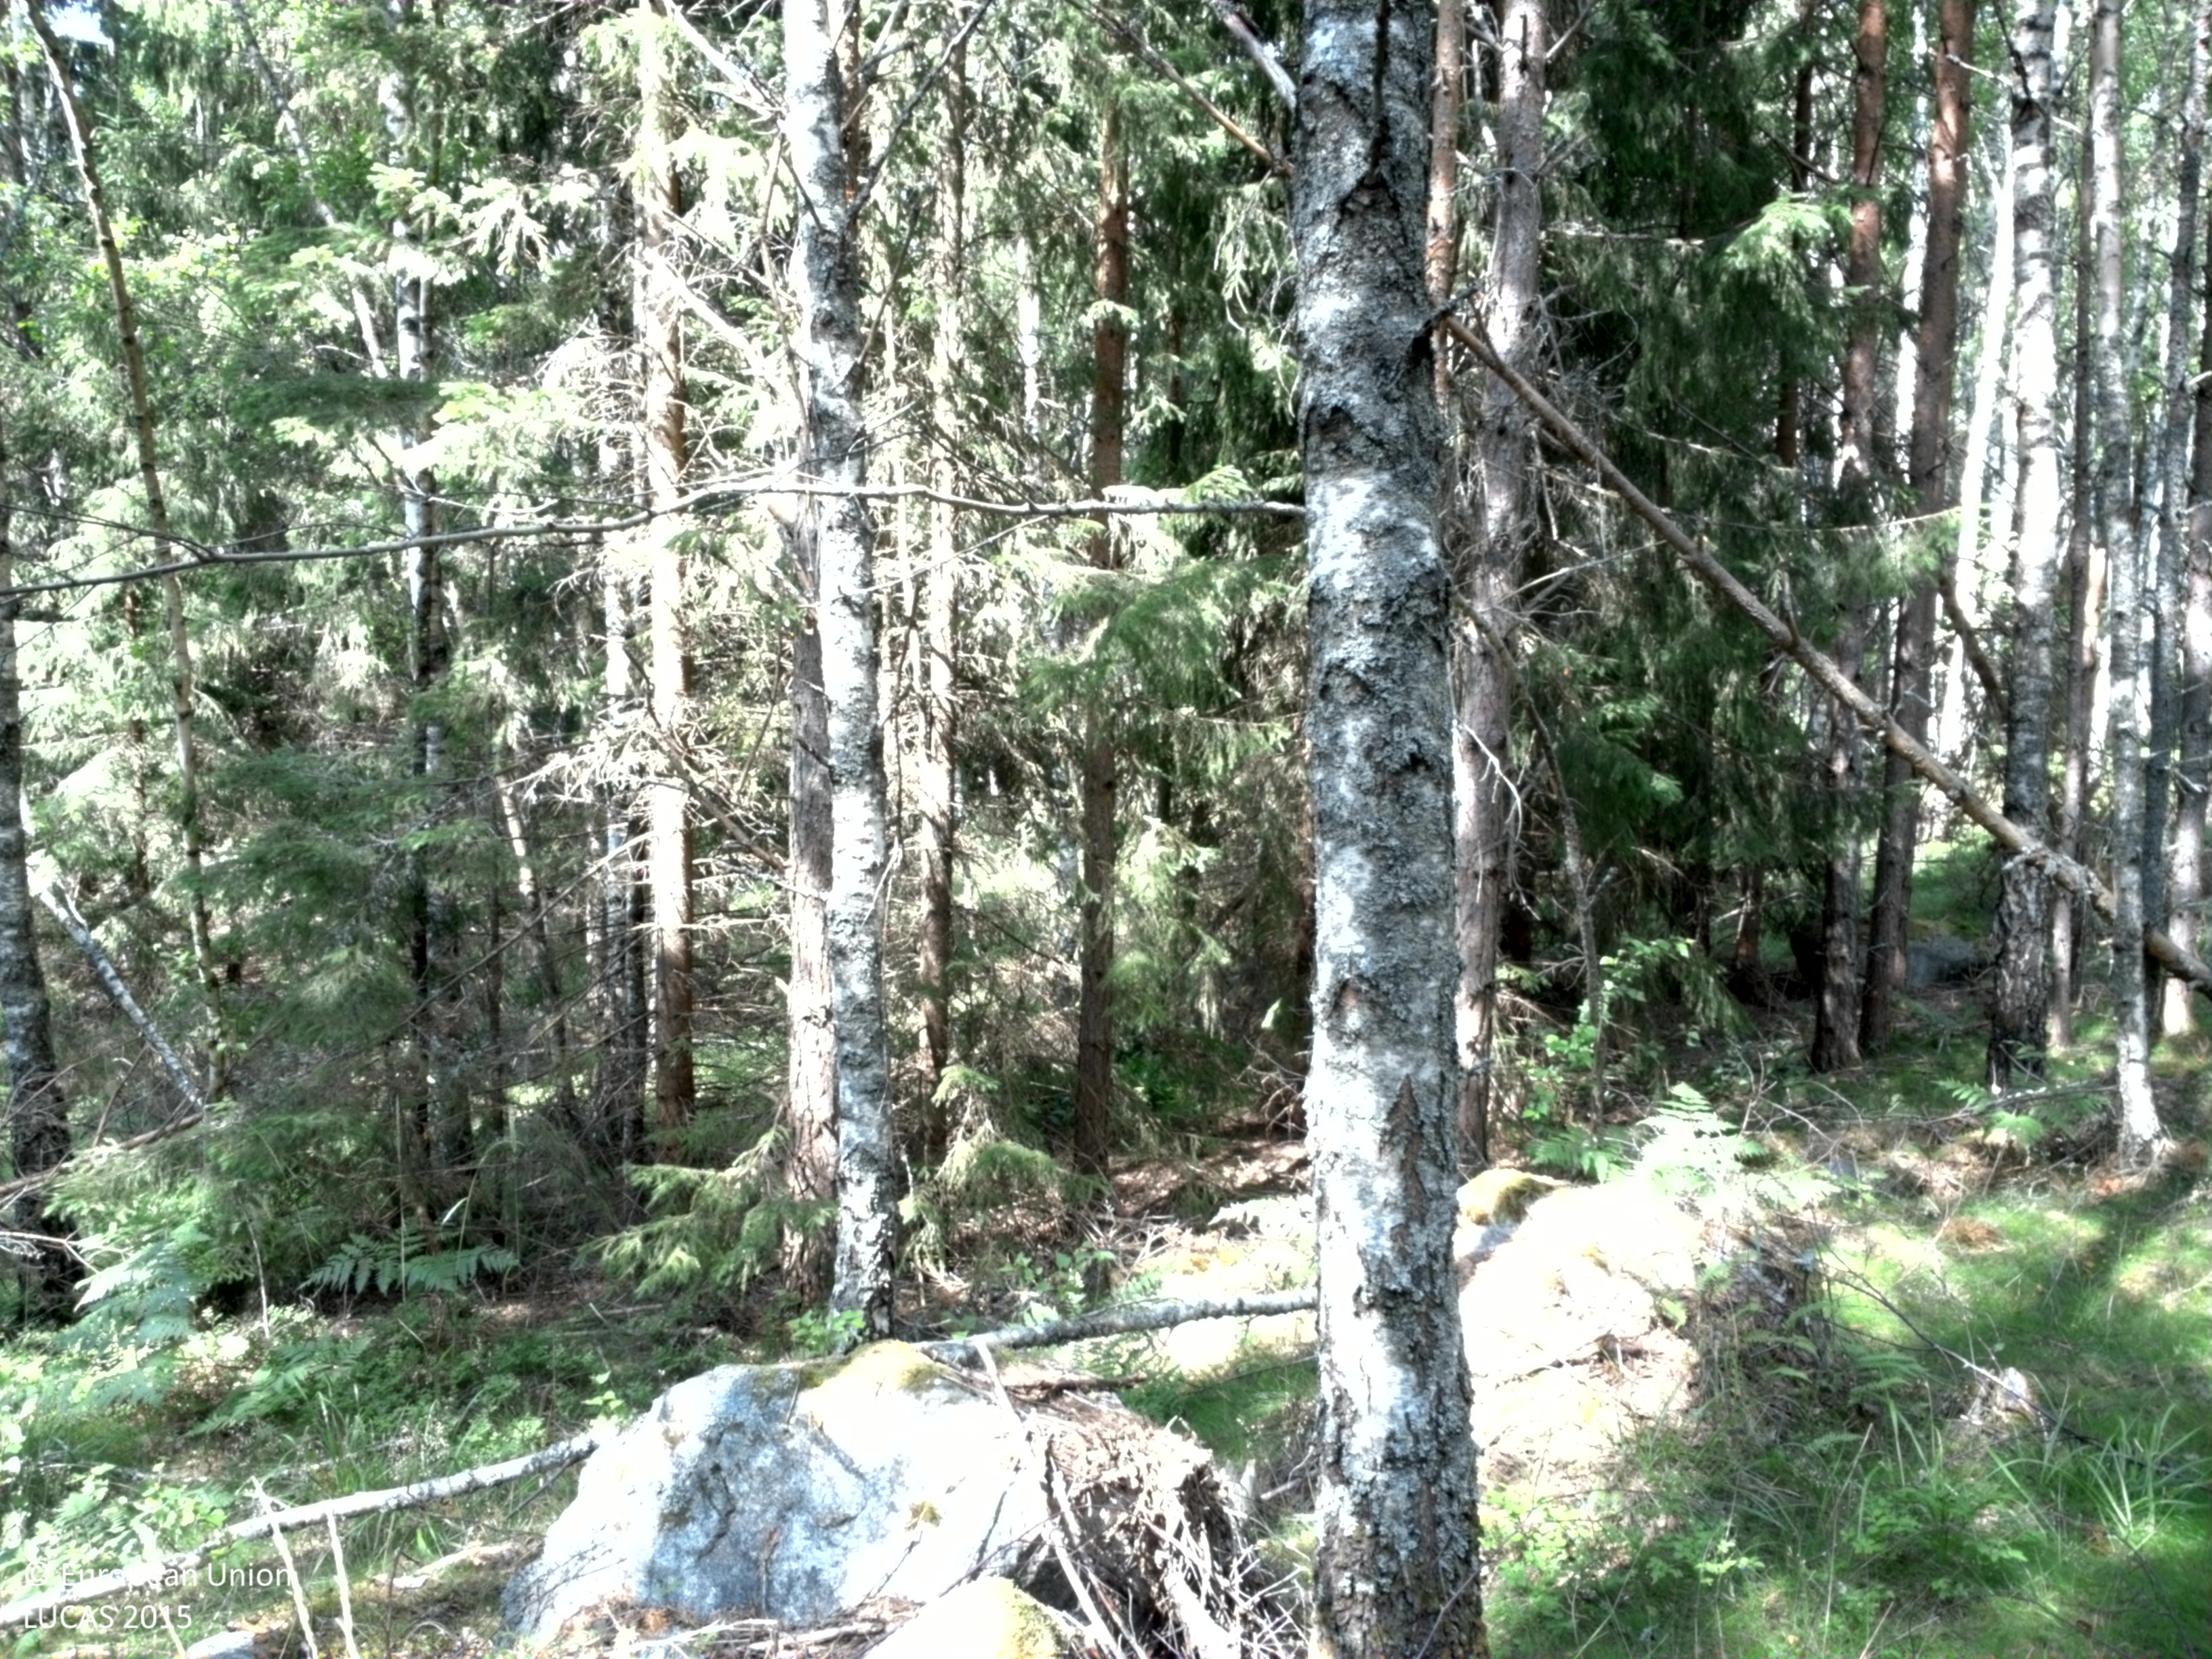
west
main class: Woodland
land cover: Pine dominated mixed woodland
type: boreal forest
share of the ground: > 75 %
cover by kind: coniferous forest trees 50 %, broadleaved forest trees 25 %, herbaceous plants 20 %, shrubs 5 %
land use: Forestry
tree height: > 5 m
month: July
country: SE
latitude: 59.6836
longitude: 18.5782
